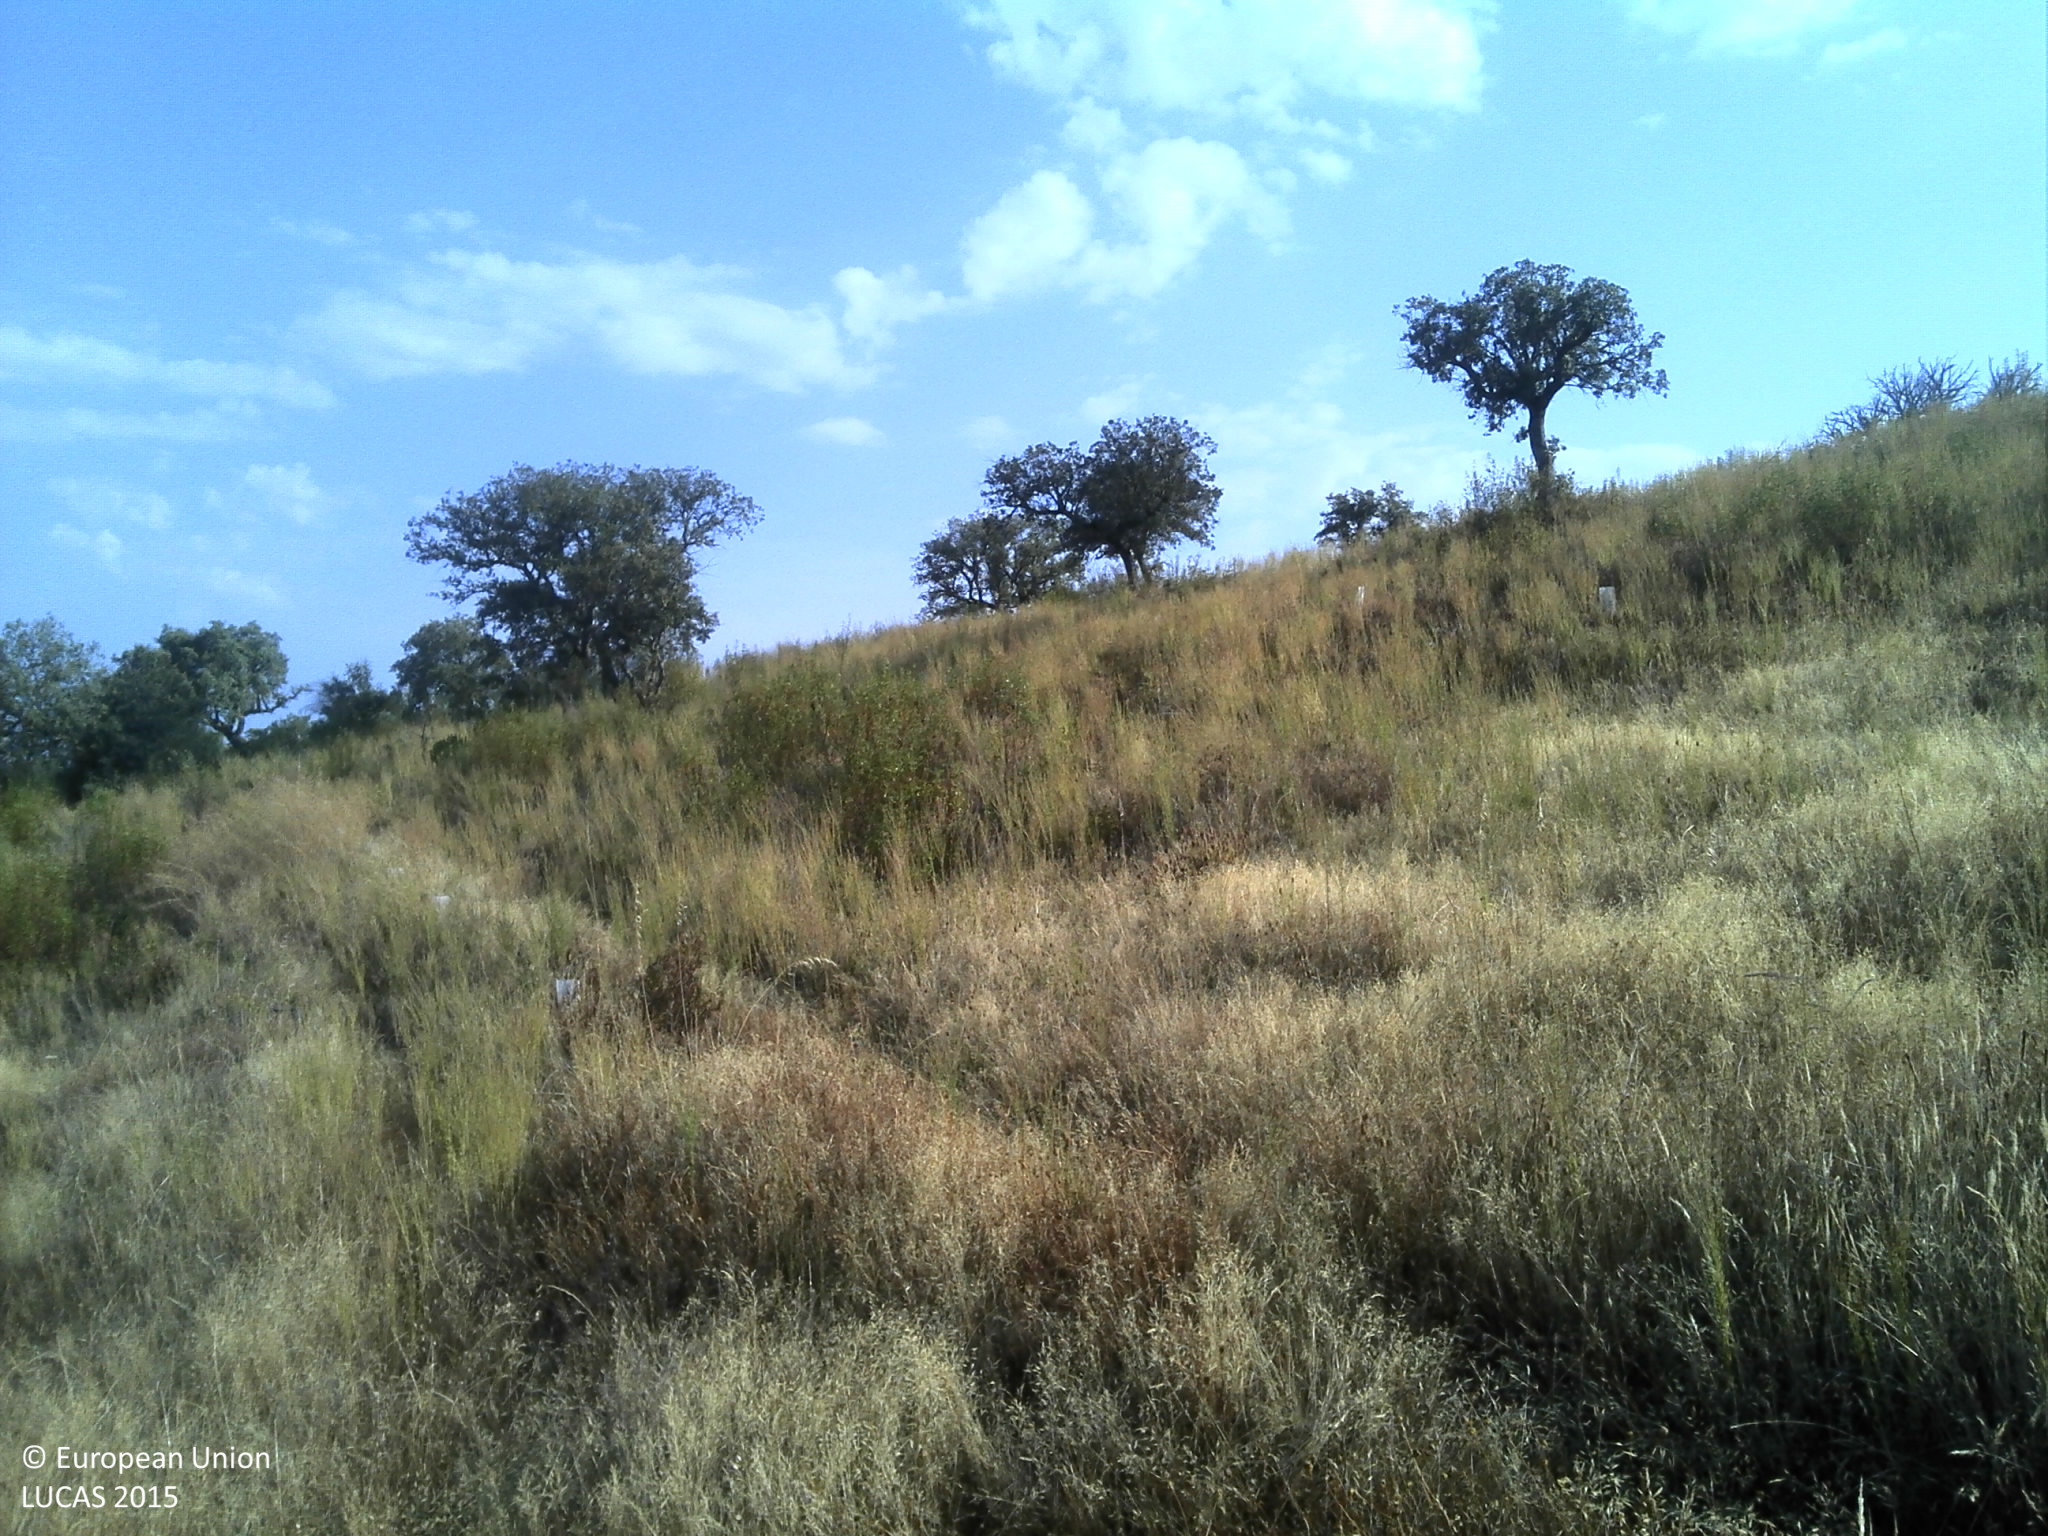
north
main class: Shrubland
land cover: Shrubland with sparse tree cover
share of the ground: 50 - 75 %
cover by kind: shrubs 60 %, unconsolidated bare surface 30 %, broadleaved forest trees 5 %, herbaceous plants 5 %
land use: Forestry
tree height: < 5 m
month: June
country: PT
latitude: 40.1052
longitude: -7.0690
